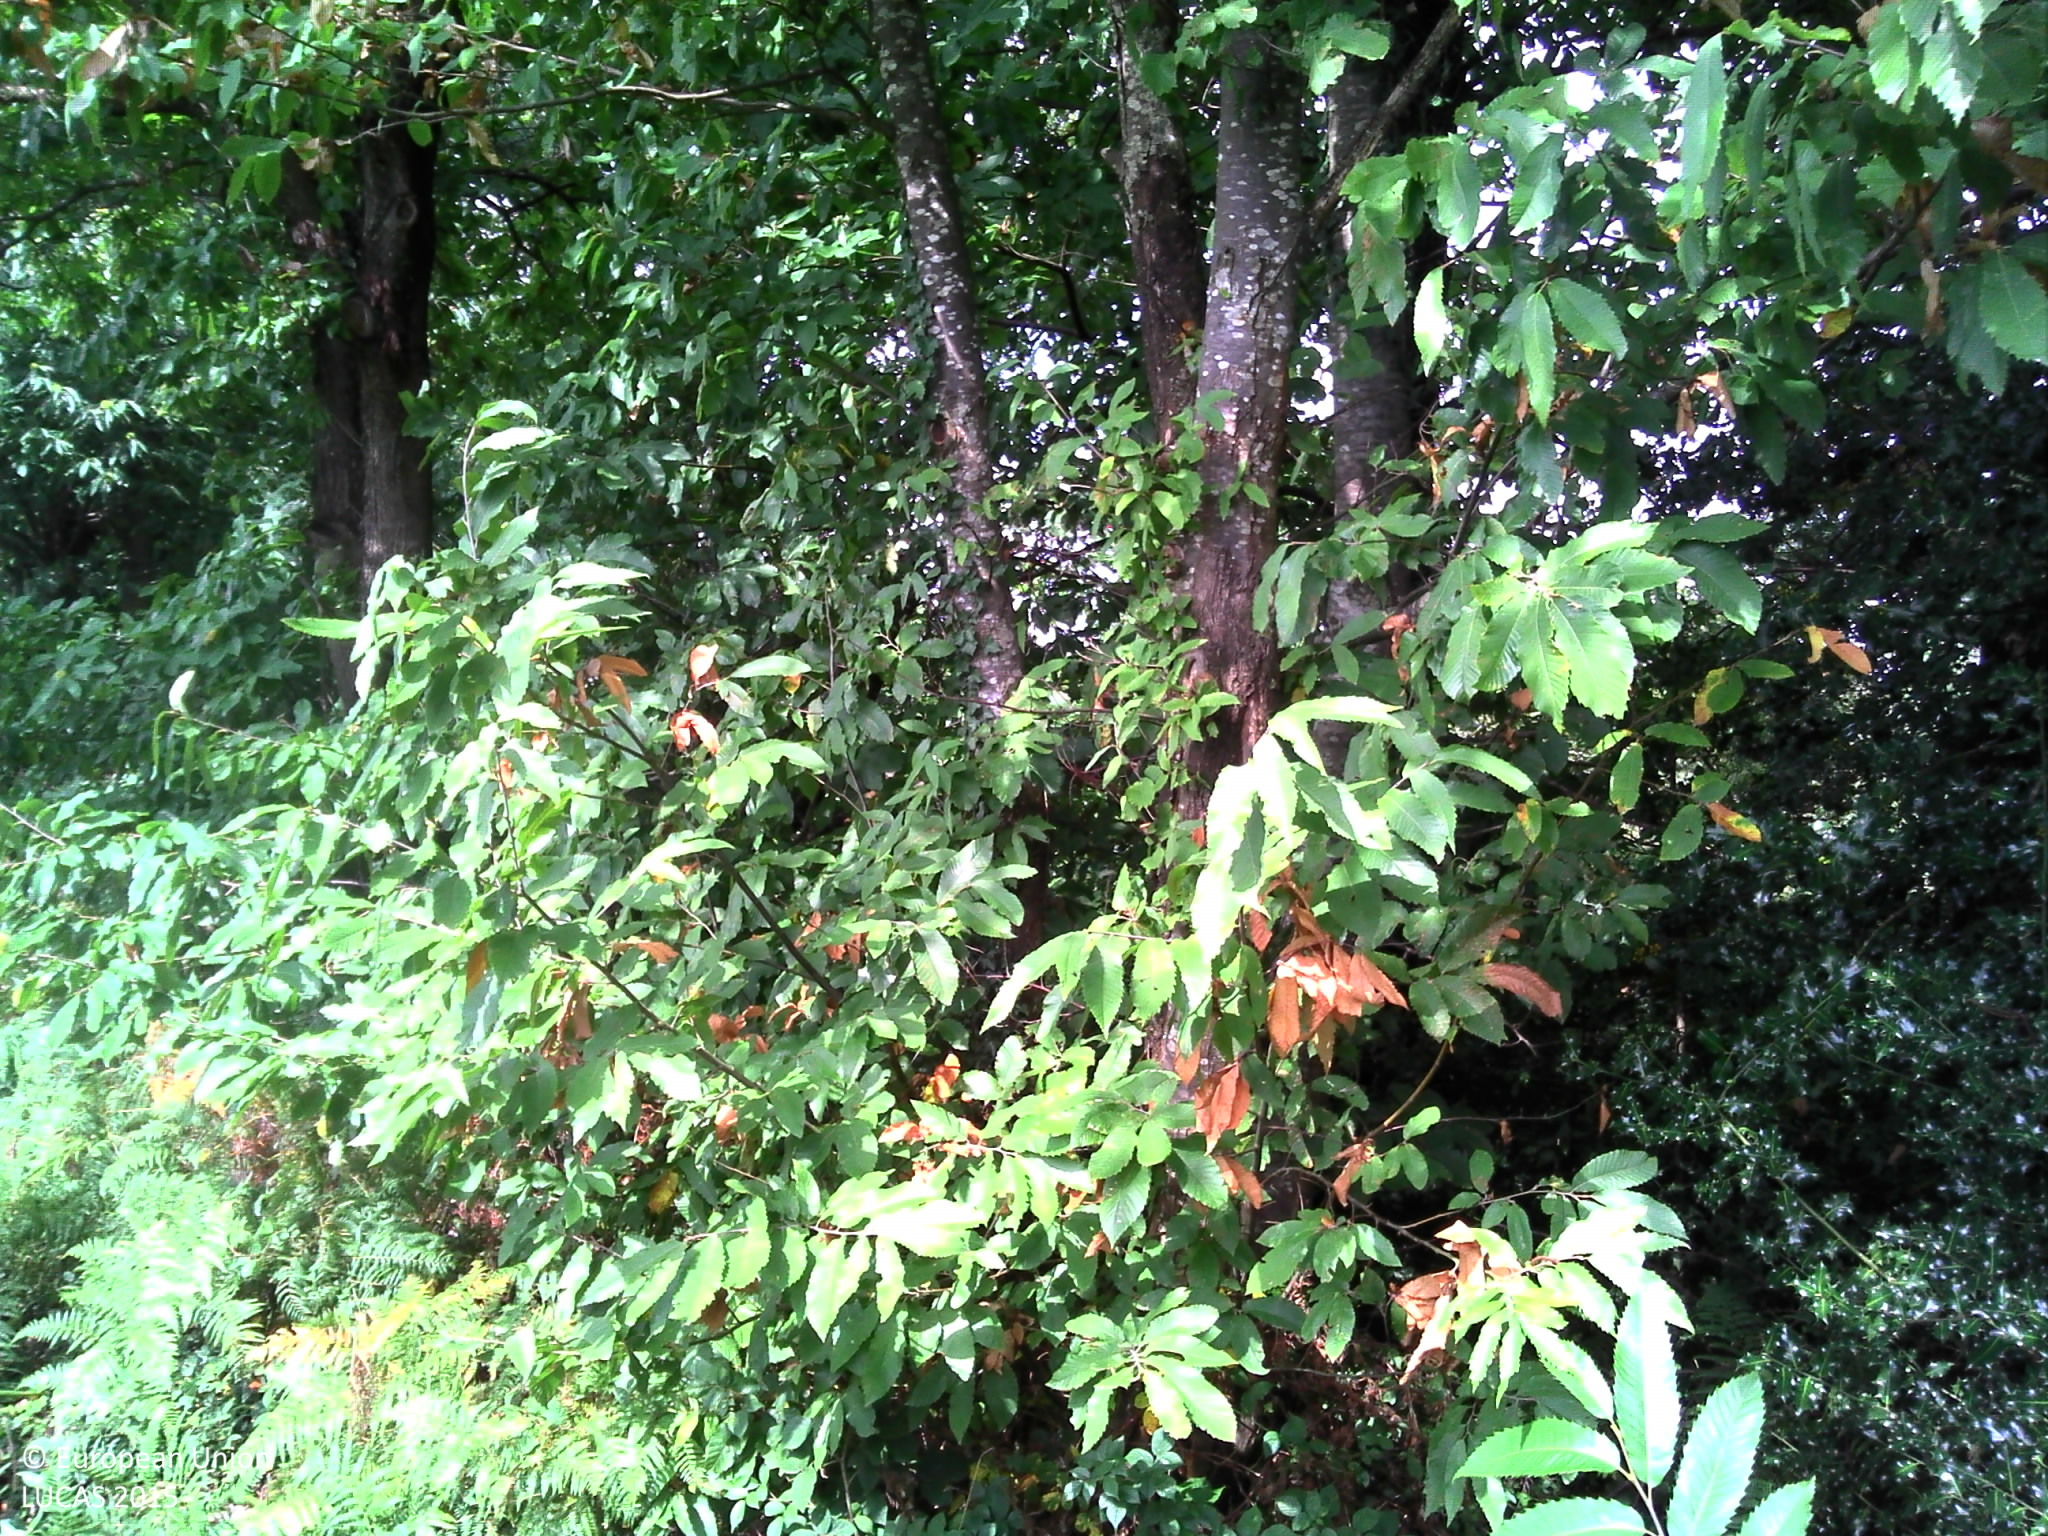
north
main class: Woodland
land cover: Broadleaved woodland
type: mesophytic deciduous forest
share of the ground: > 75 %
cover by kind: broadleaved forest trees 80 %, shrubs 10 %, herbaceous plants 5 %, lichens and mosses 5 %
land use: Forestry
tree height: > 5 m
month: September
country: FR
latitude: 43.4493
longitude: -0.1762
